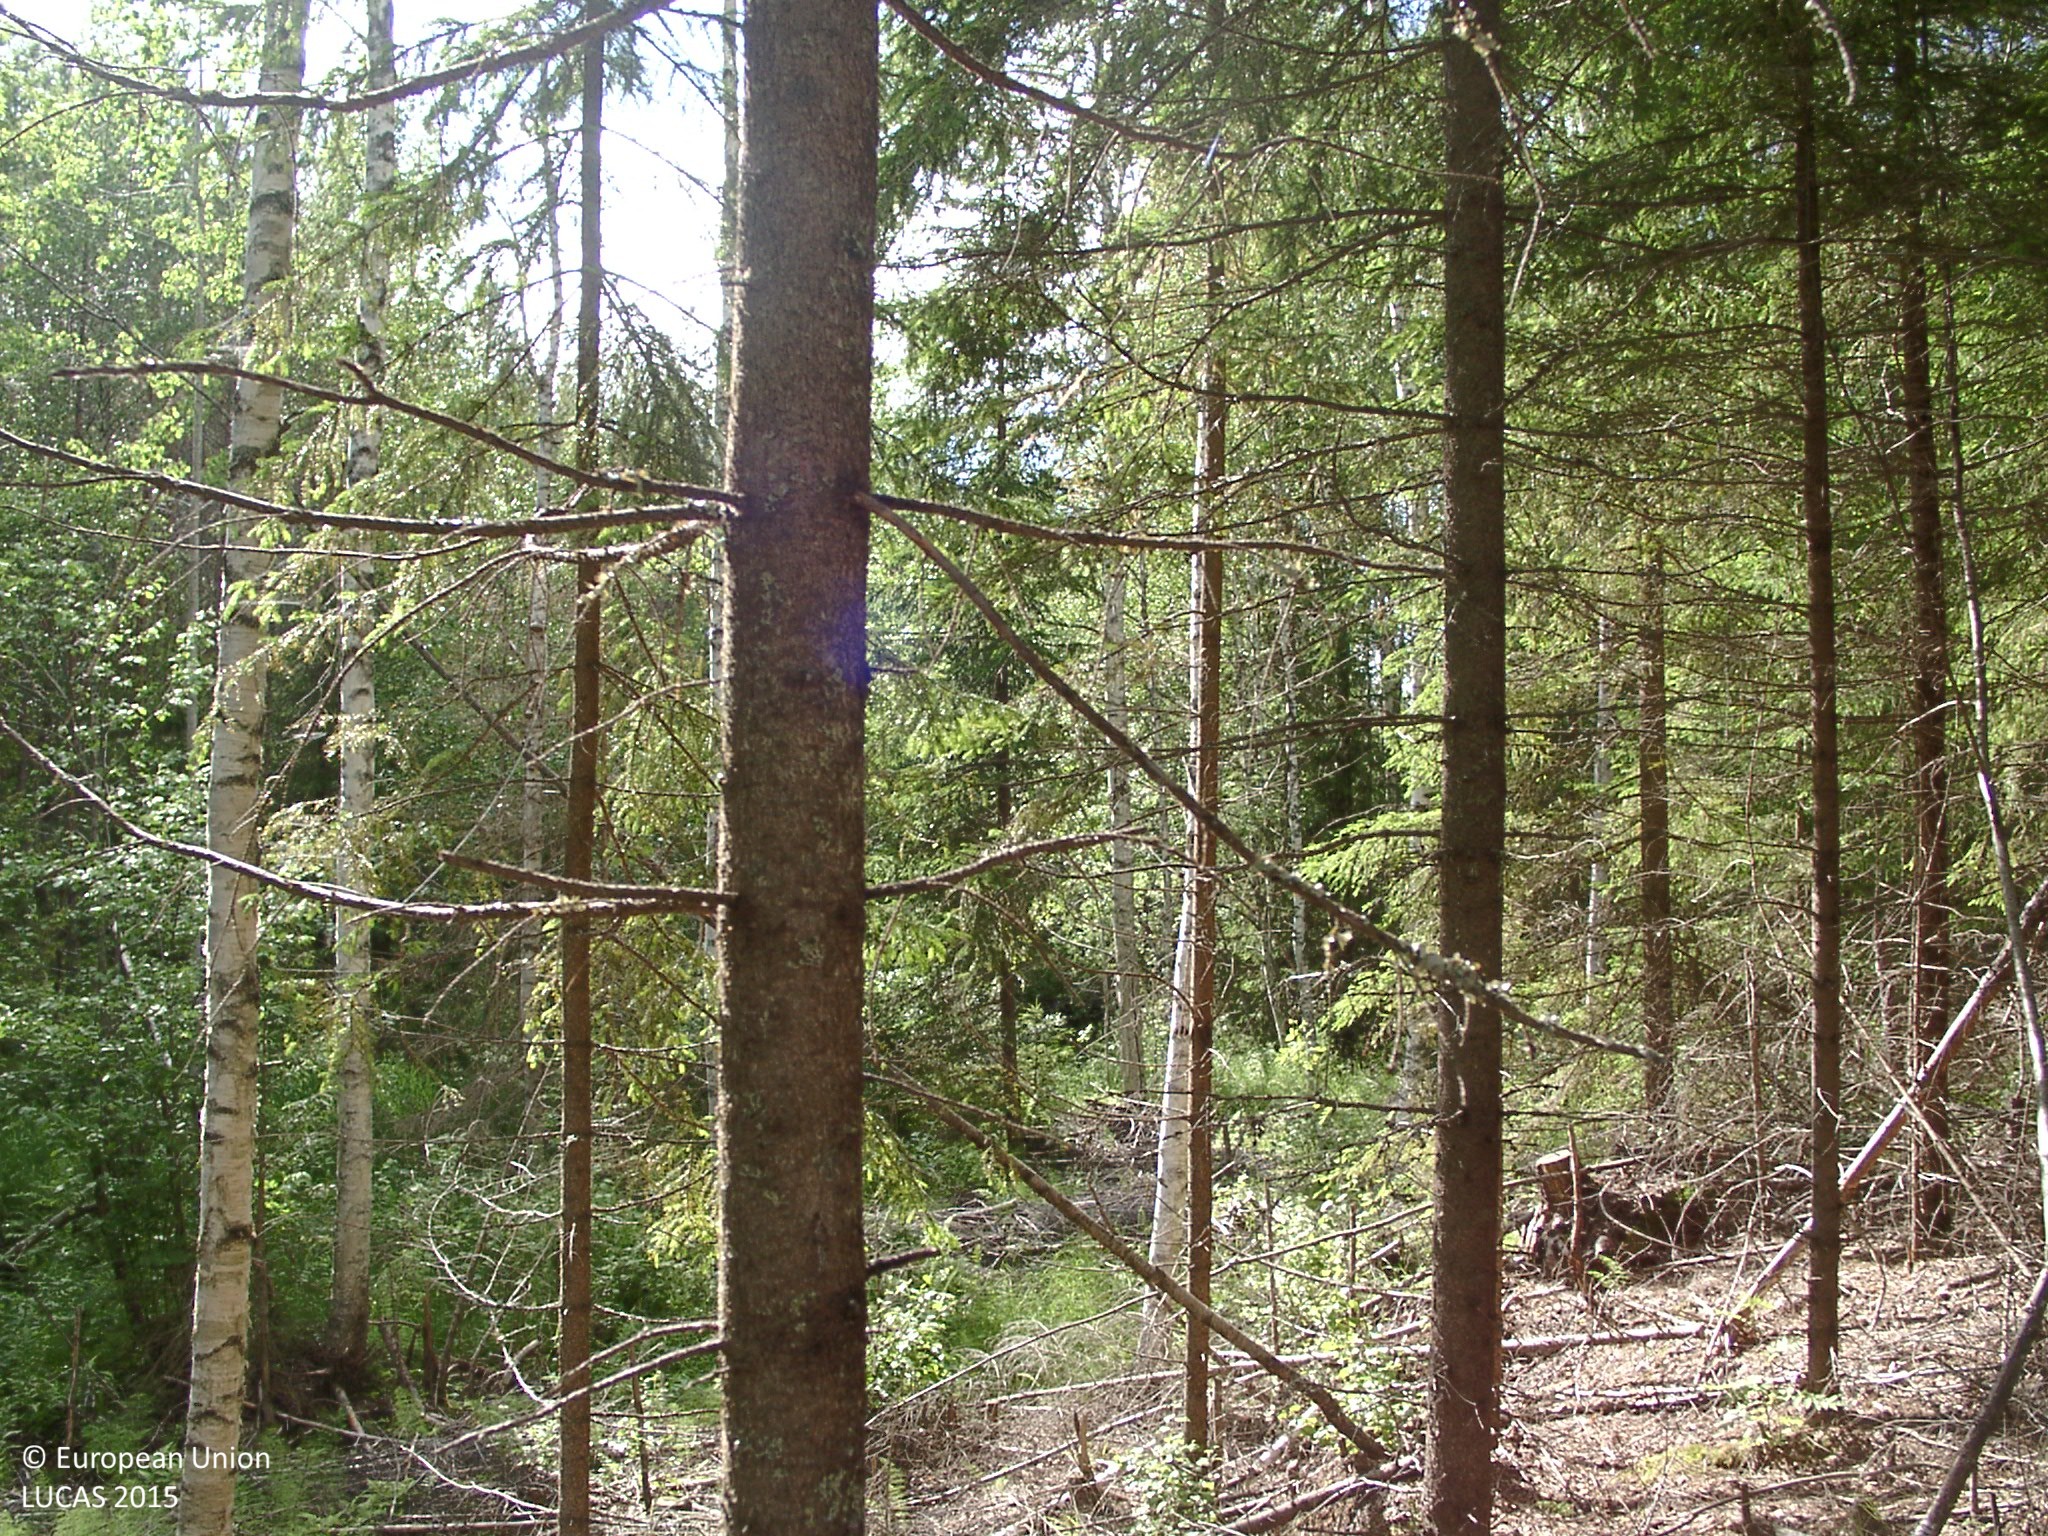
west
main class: Woodland
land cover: Other coniferous woodland
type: boreal forest
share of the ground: > 75 %
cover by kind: coniferous forest trees 70 %, broadleaved forest trees 5 %, unconsolidated bare surface 5 %
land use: Forestry
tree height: > 5 m
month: July
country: FI
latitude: 62.2106
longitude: 25.1217
